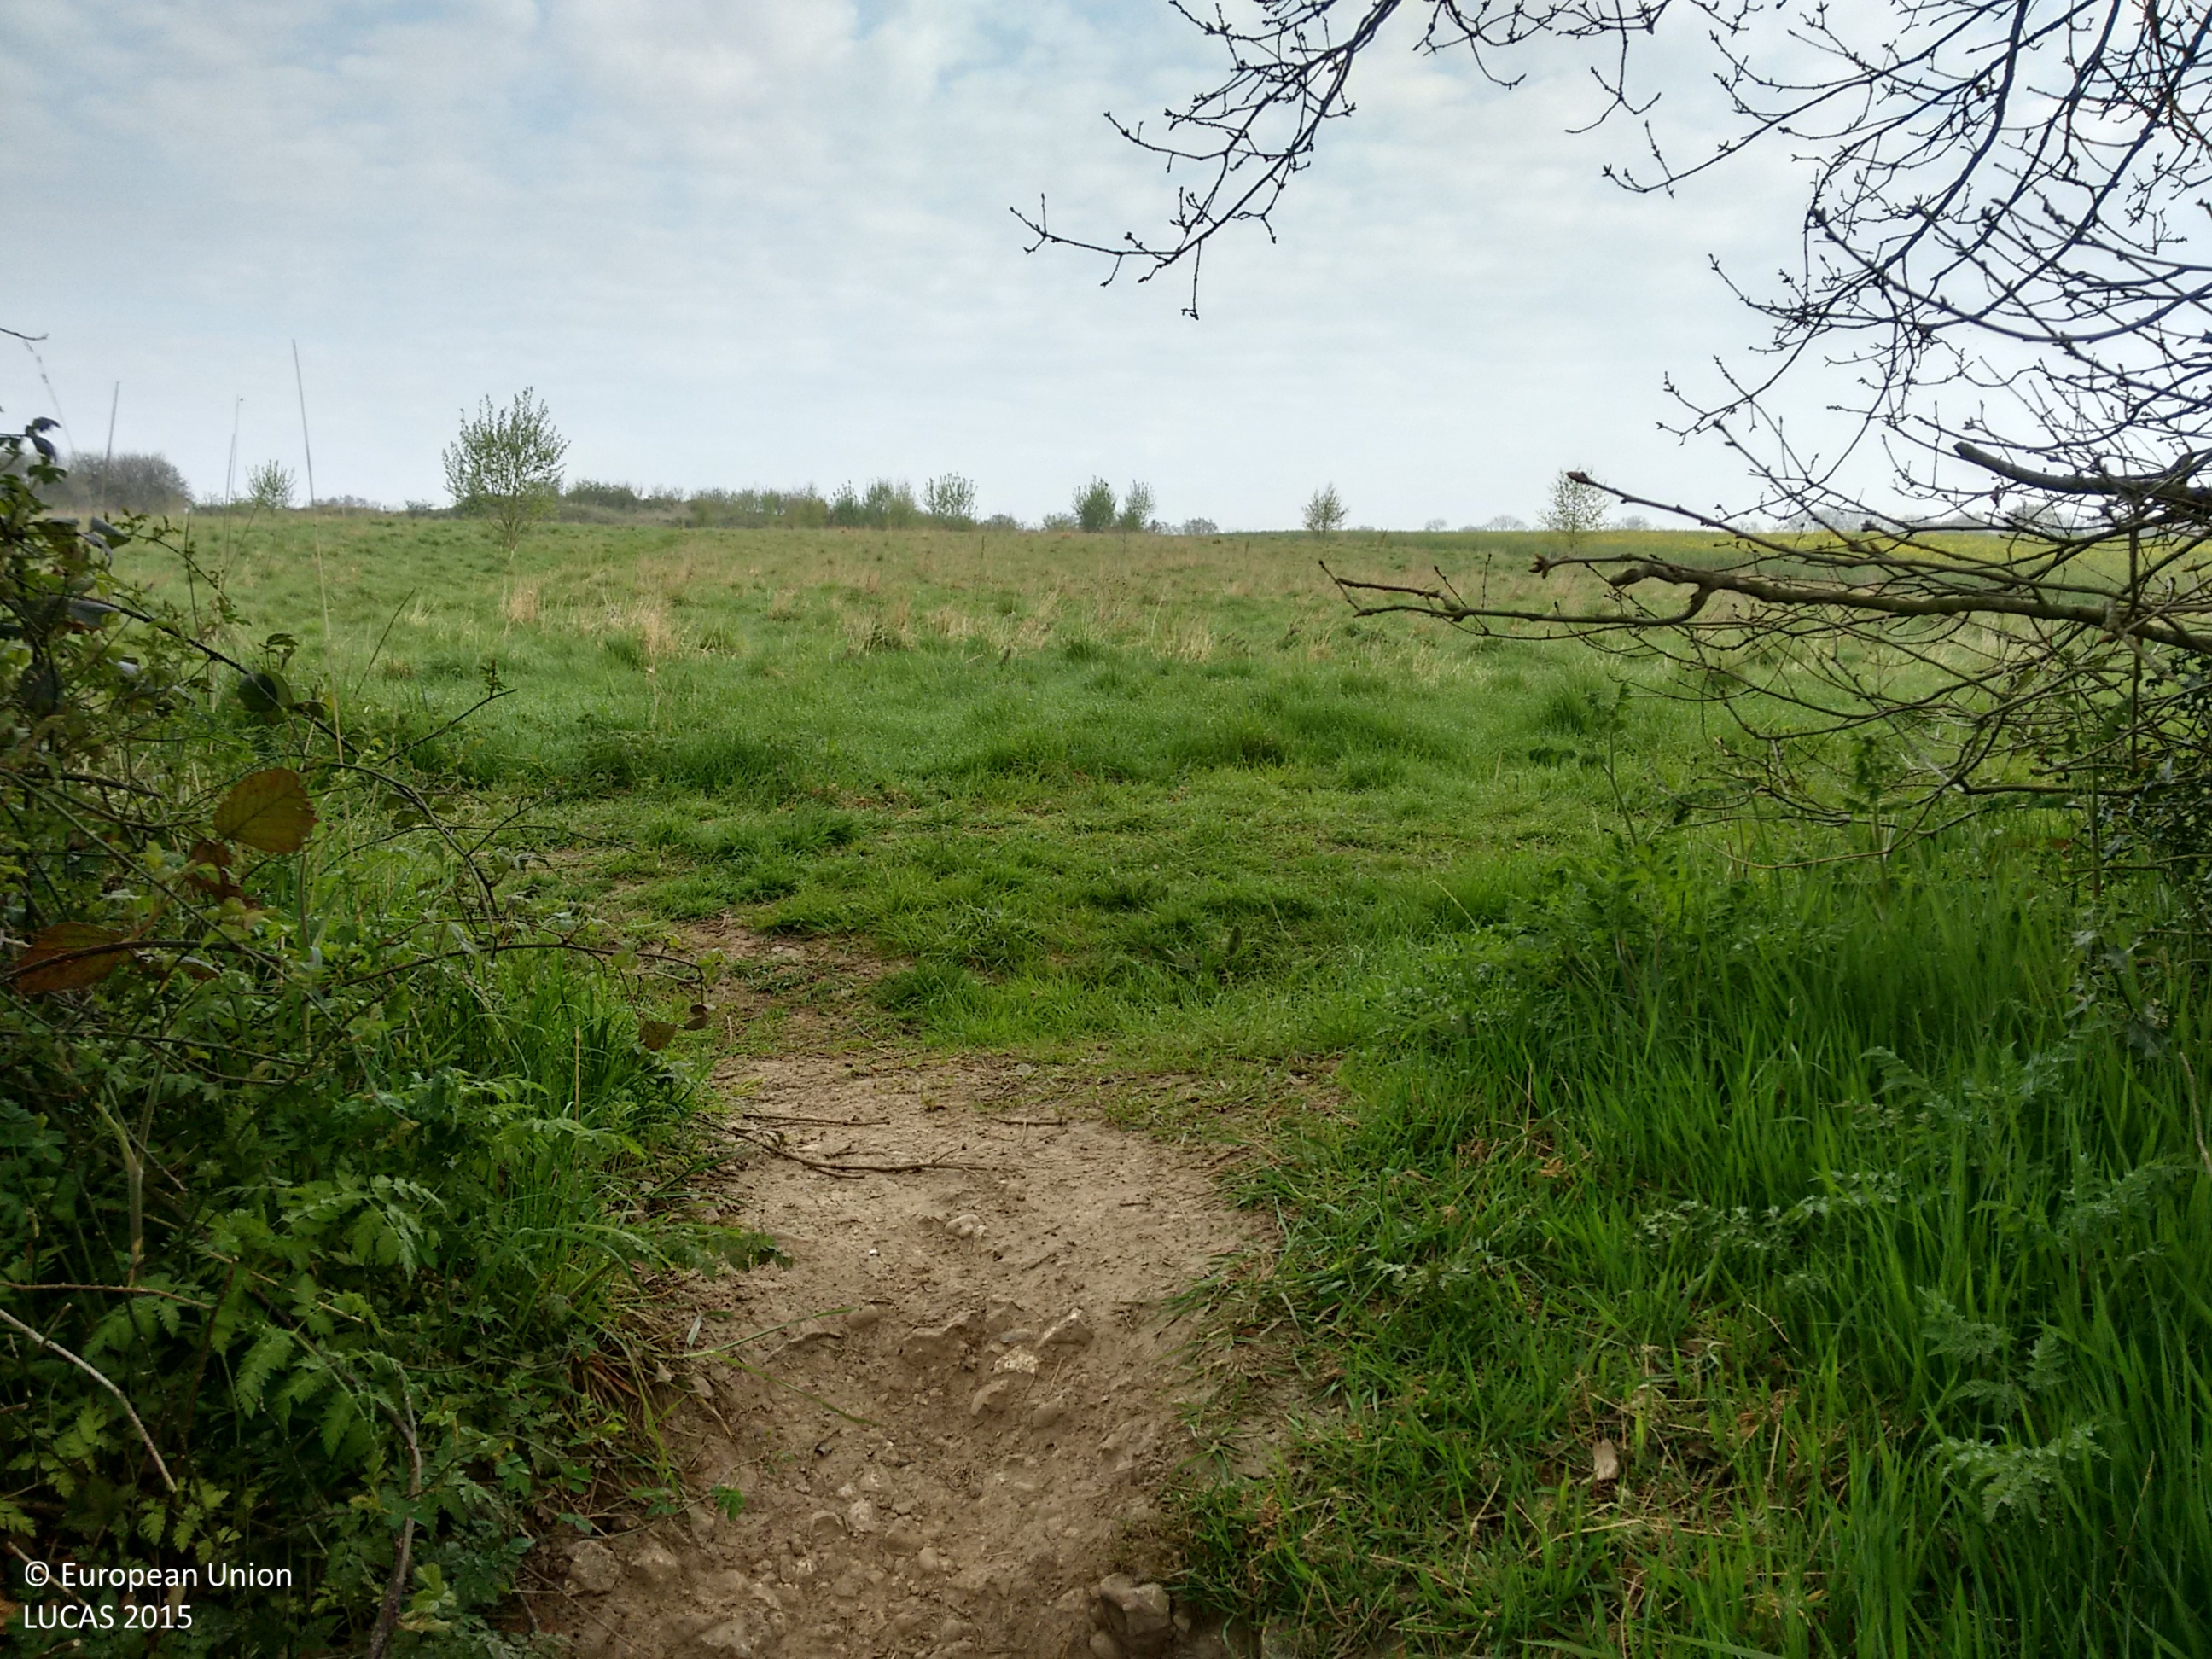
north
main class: Woodland
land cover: Broadleaved woodland
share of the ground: > 75 %
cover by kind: broadleaved forest trees 95 %, consolidated bare surface 5 %
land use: Semi-natural and natural areas not in use
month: April
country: GB
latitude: 51.6544
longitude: -0.7229
